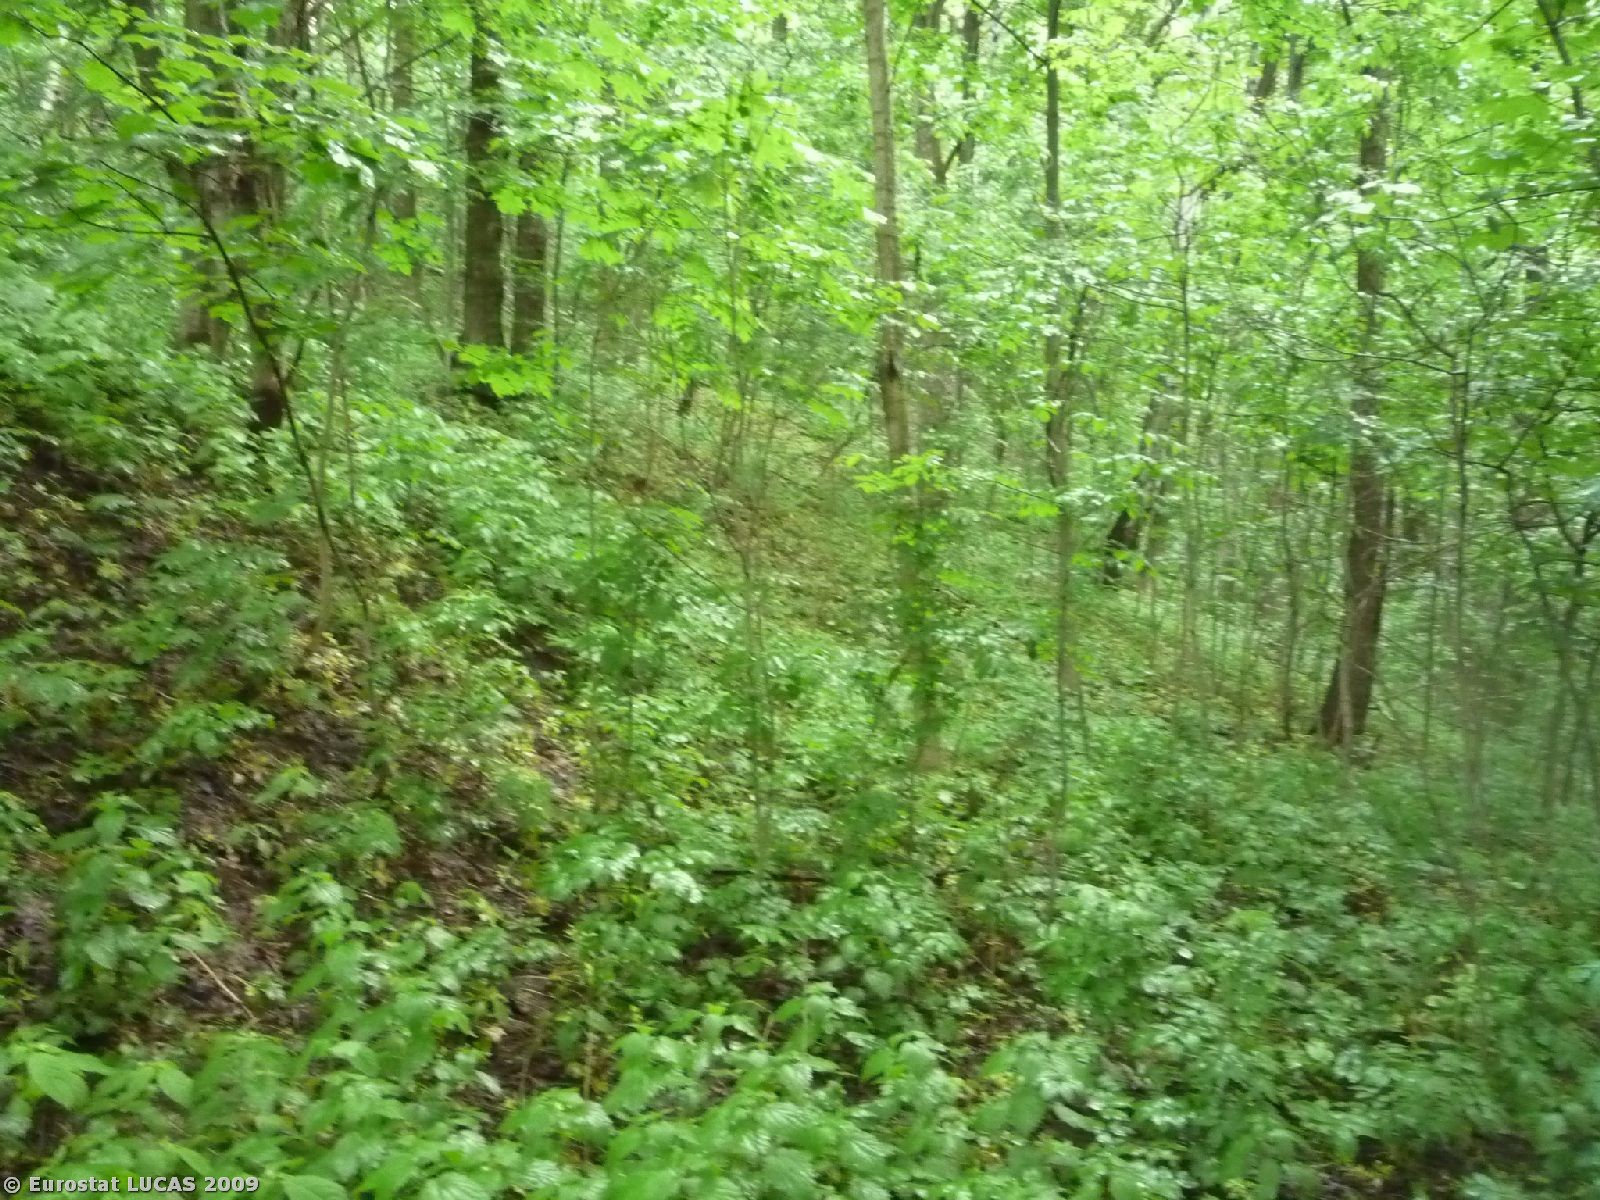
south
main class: Woodland
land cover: Broadleaved woodland
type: mesophytic deciduous forest
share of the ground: > 75 %
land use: Forestry
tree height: > 5 m
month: June
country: CZ
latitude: 50.6254
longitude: 15.5598
